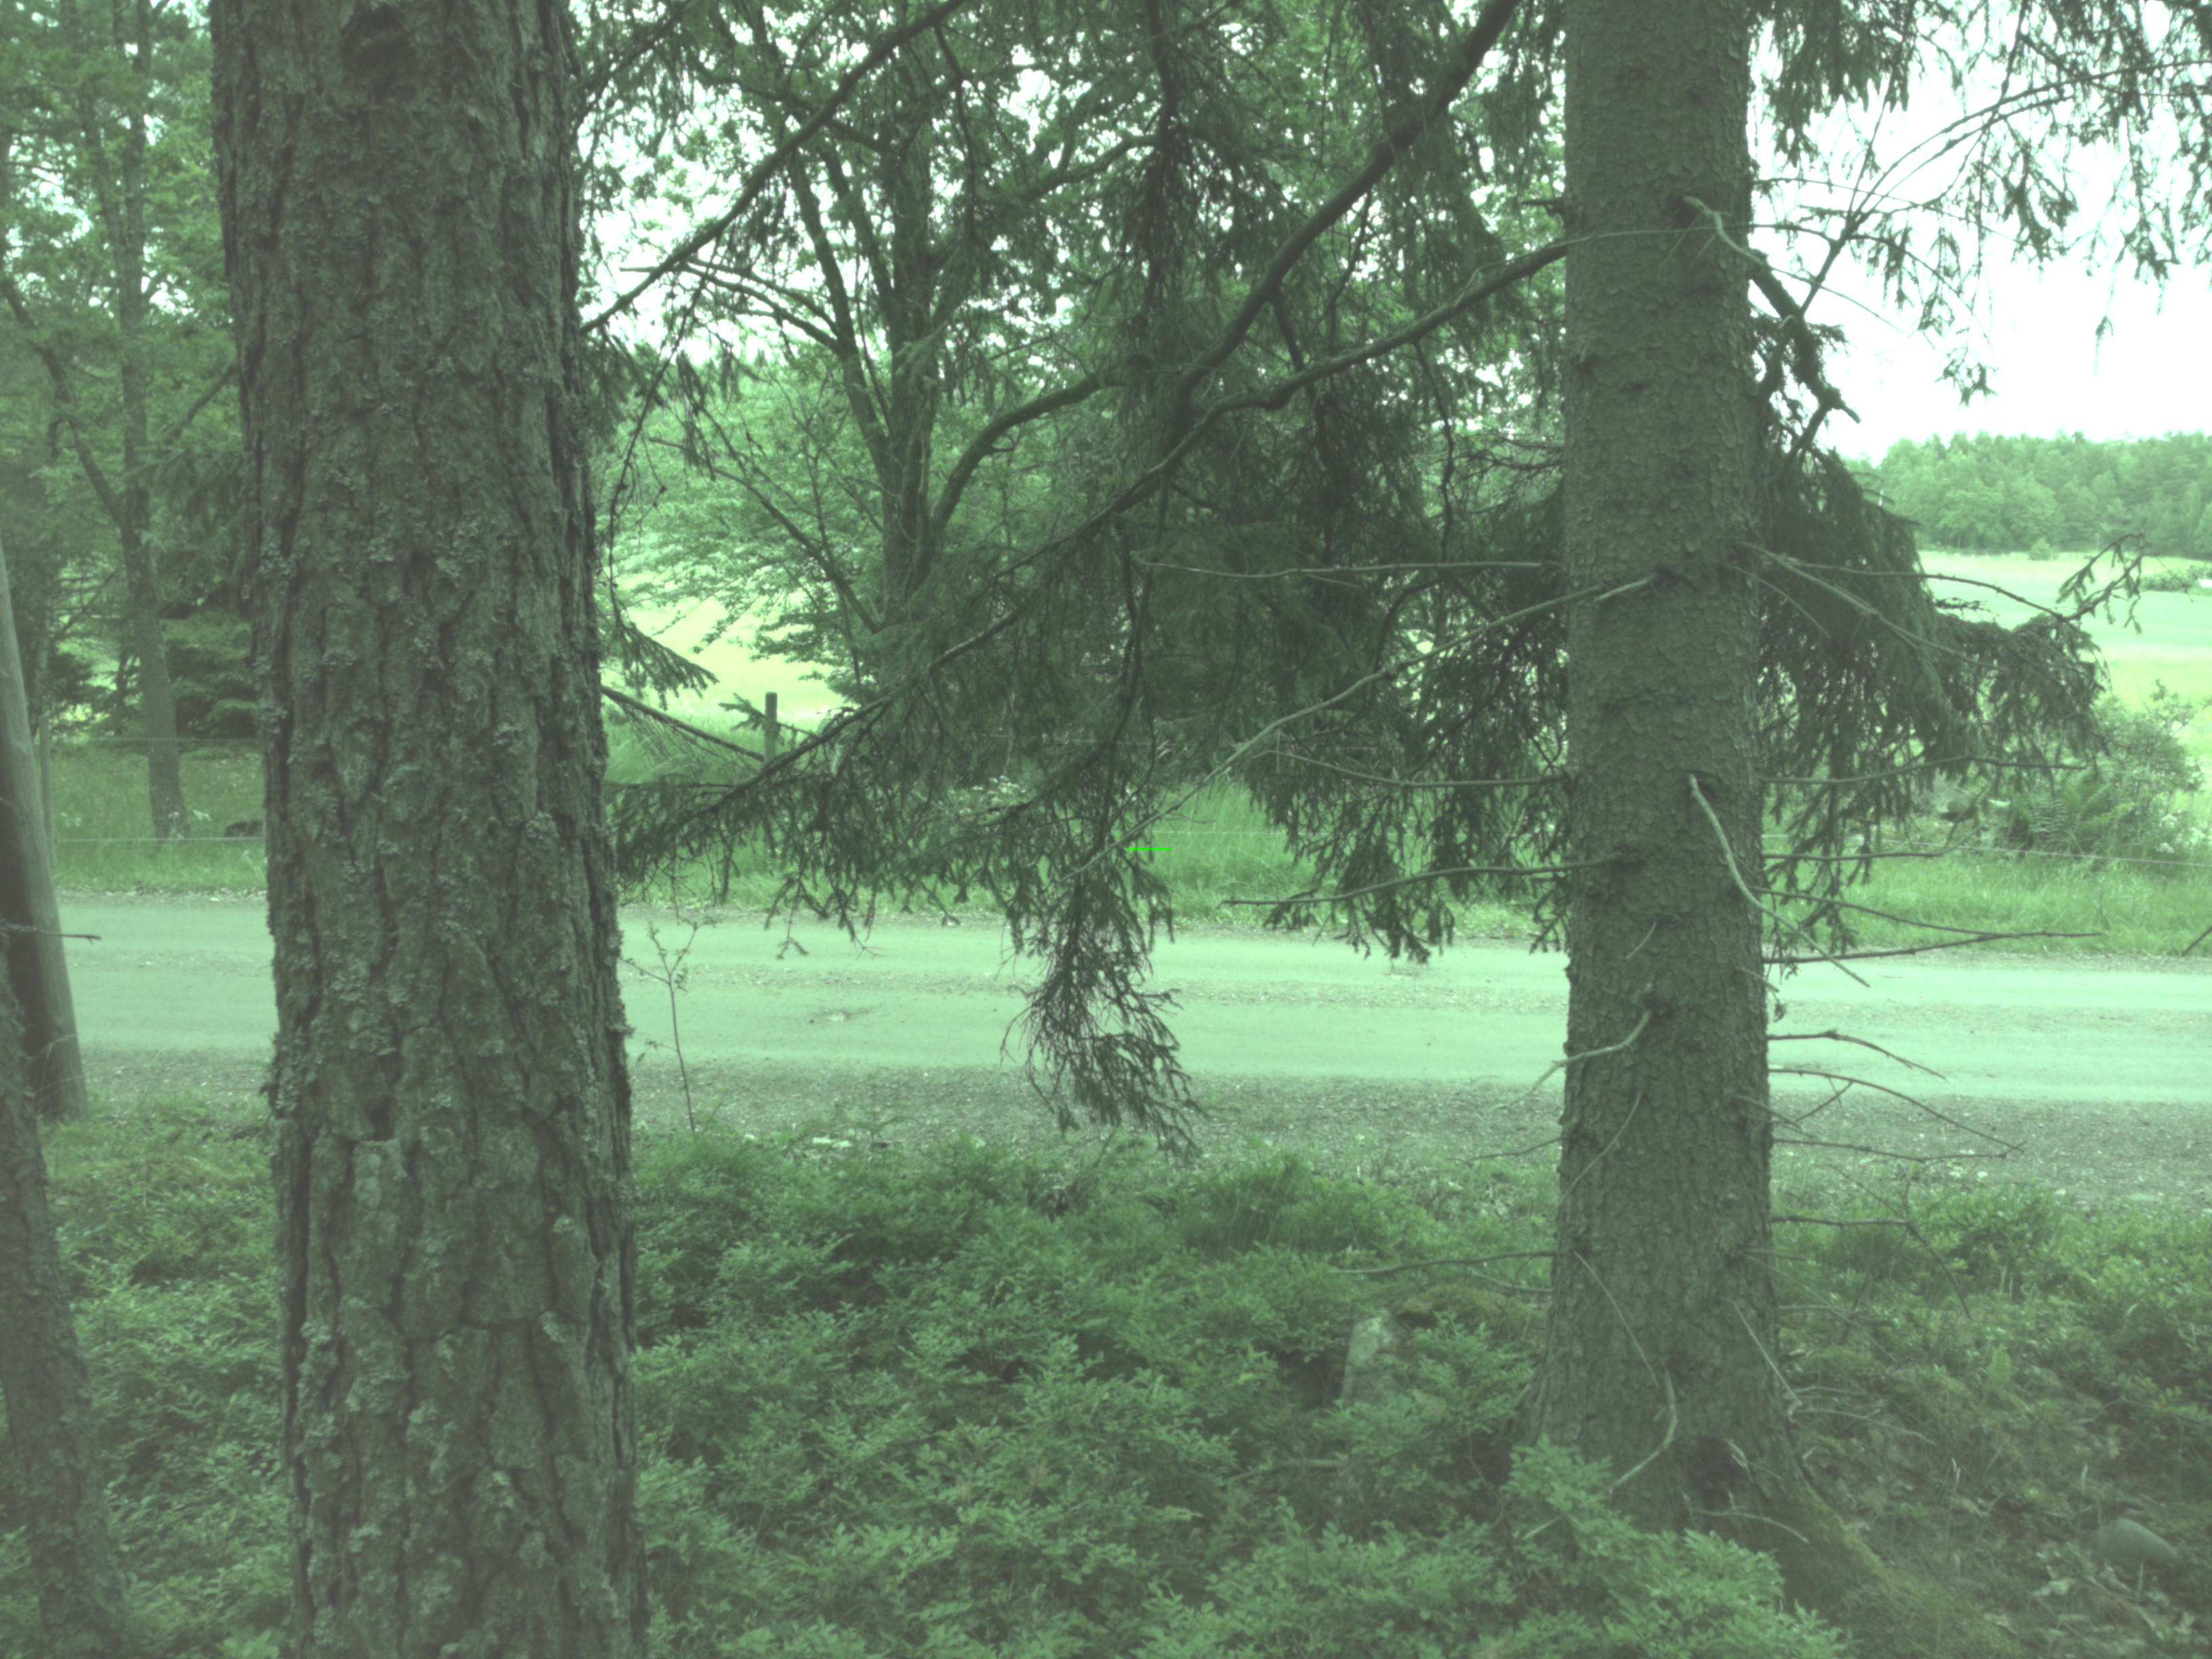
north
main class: Woodland
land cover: Spruce dominated coniferous woodland
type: boreal forest
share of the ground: 50 - 75 %
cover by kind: coniferous forest trees 60 %, shrubs 30 %, lichens and mosses 10 %
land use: Forestry
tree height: > 5 m
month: June
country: SE
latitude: 59.2818
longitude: 17.3850
